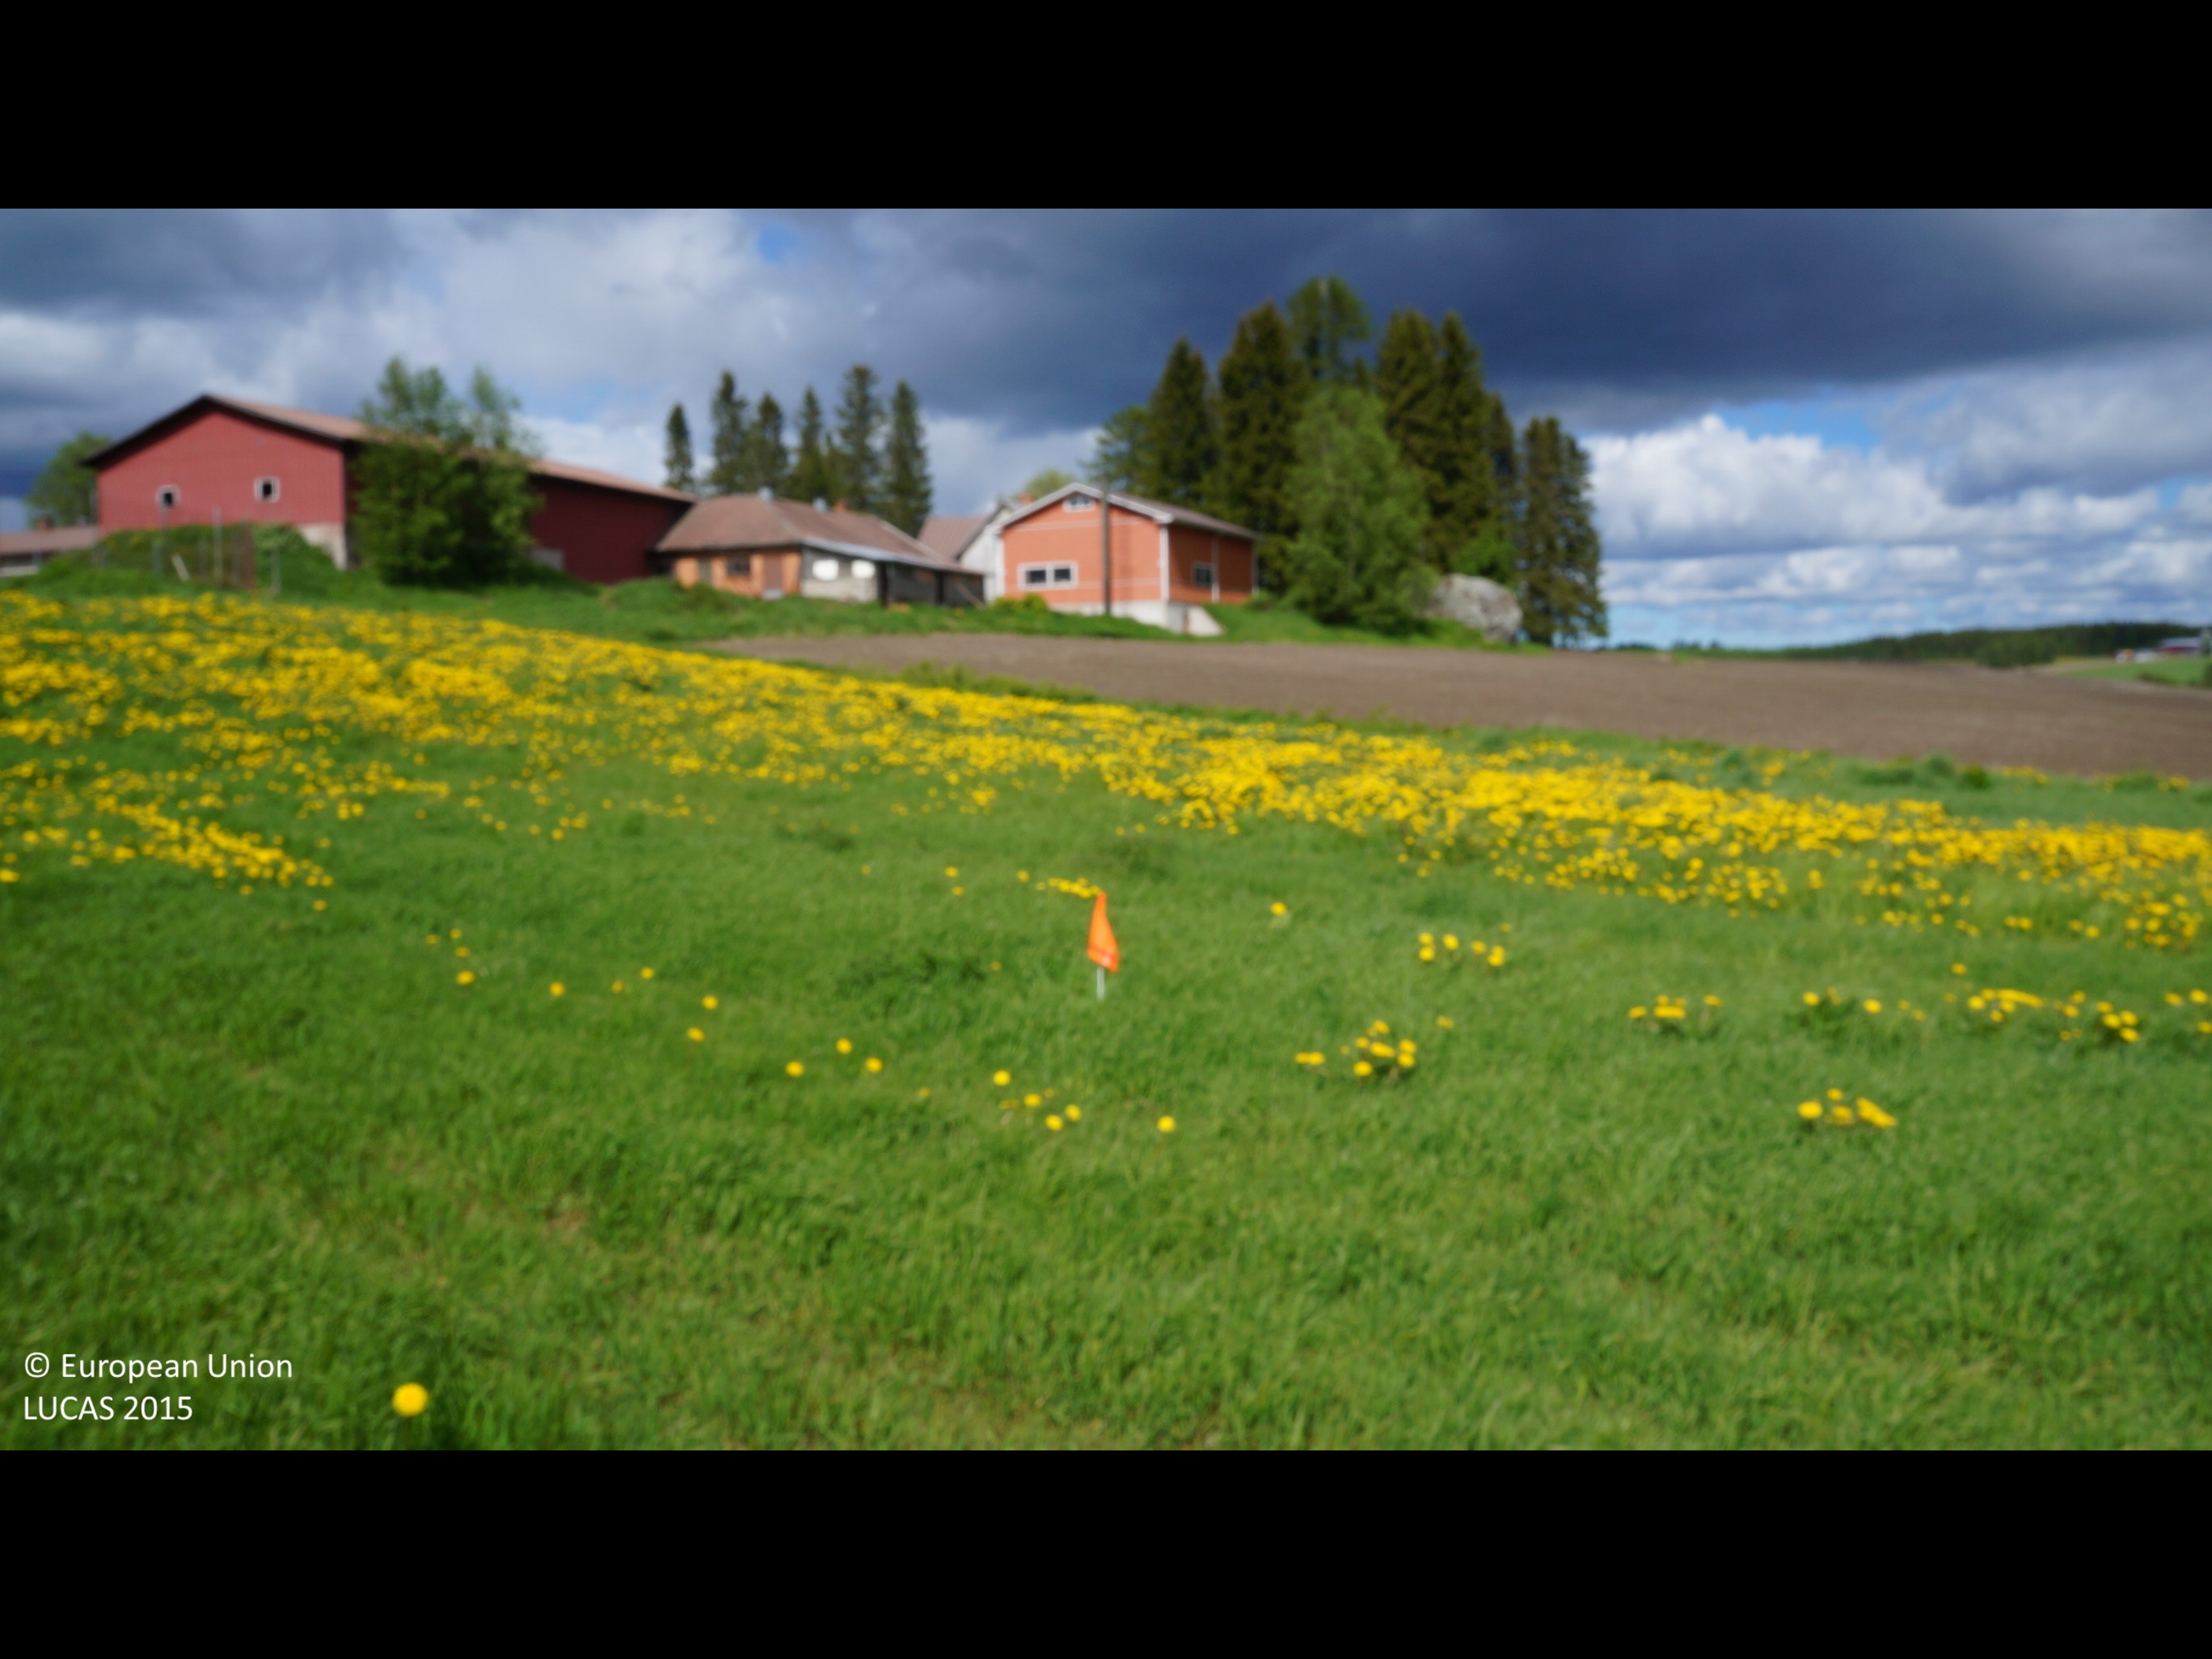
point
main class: Cropland
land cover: Temporary grasslands
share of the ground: > 75 %
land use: Agriculture (excluding fallow land and kitchen gardens)
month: June
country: FI
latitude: 63.7657
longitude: 24.2868
